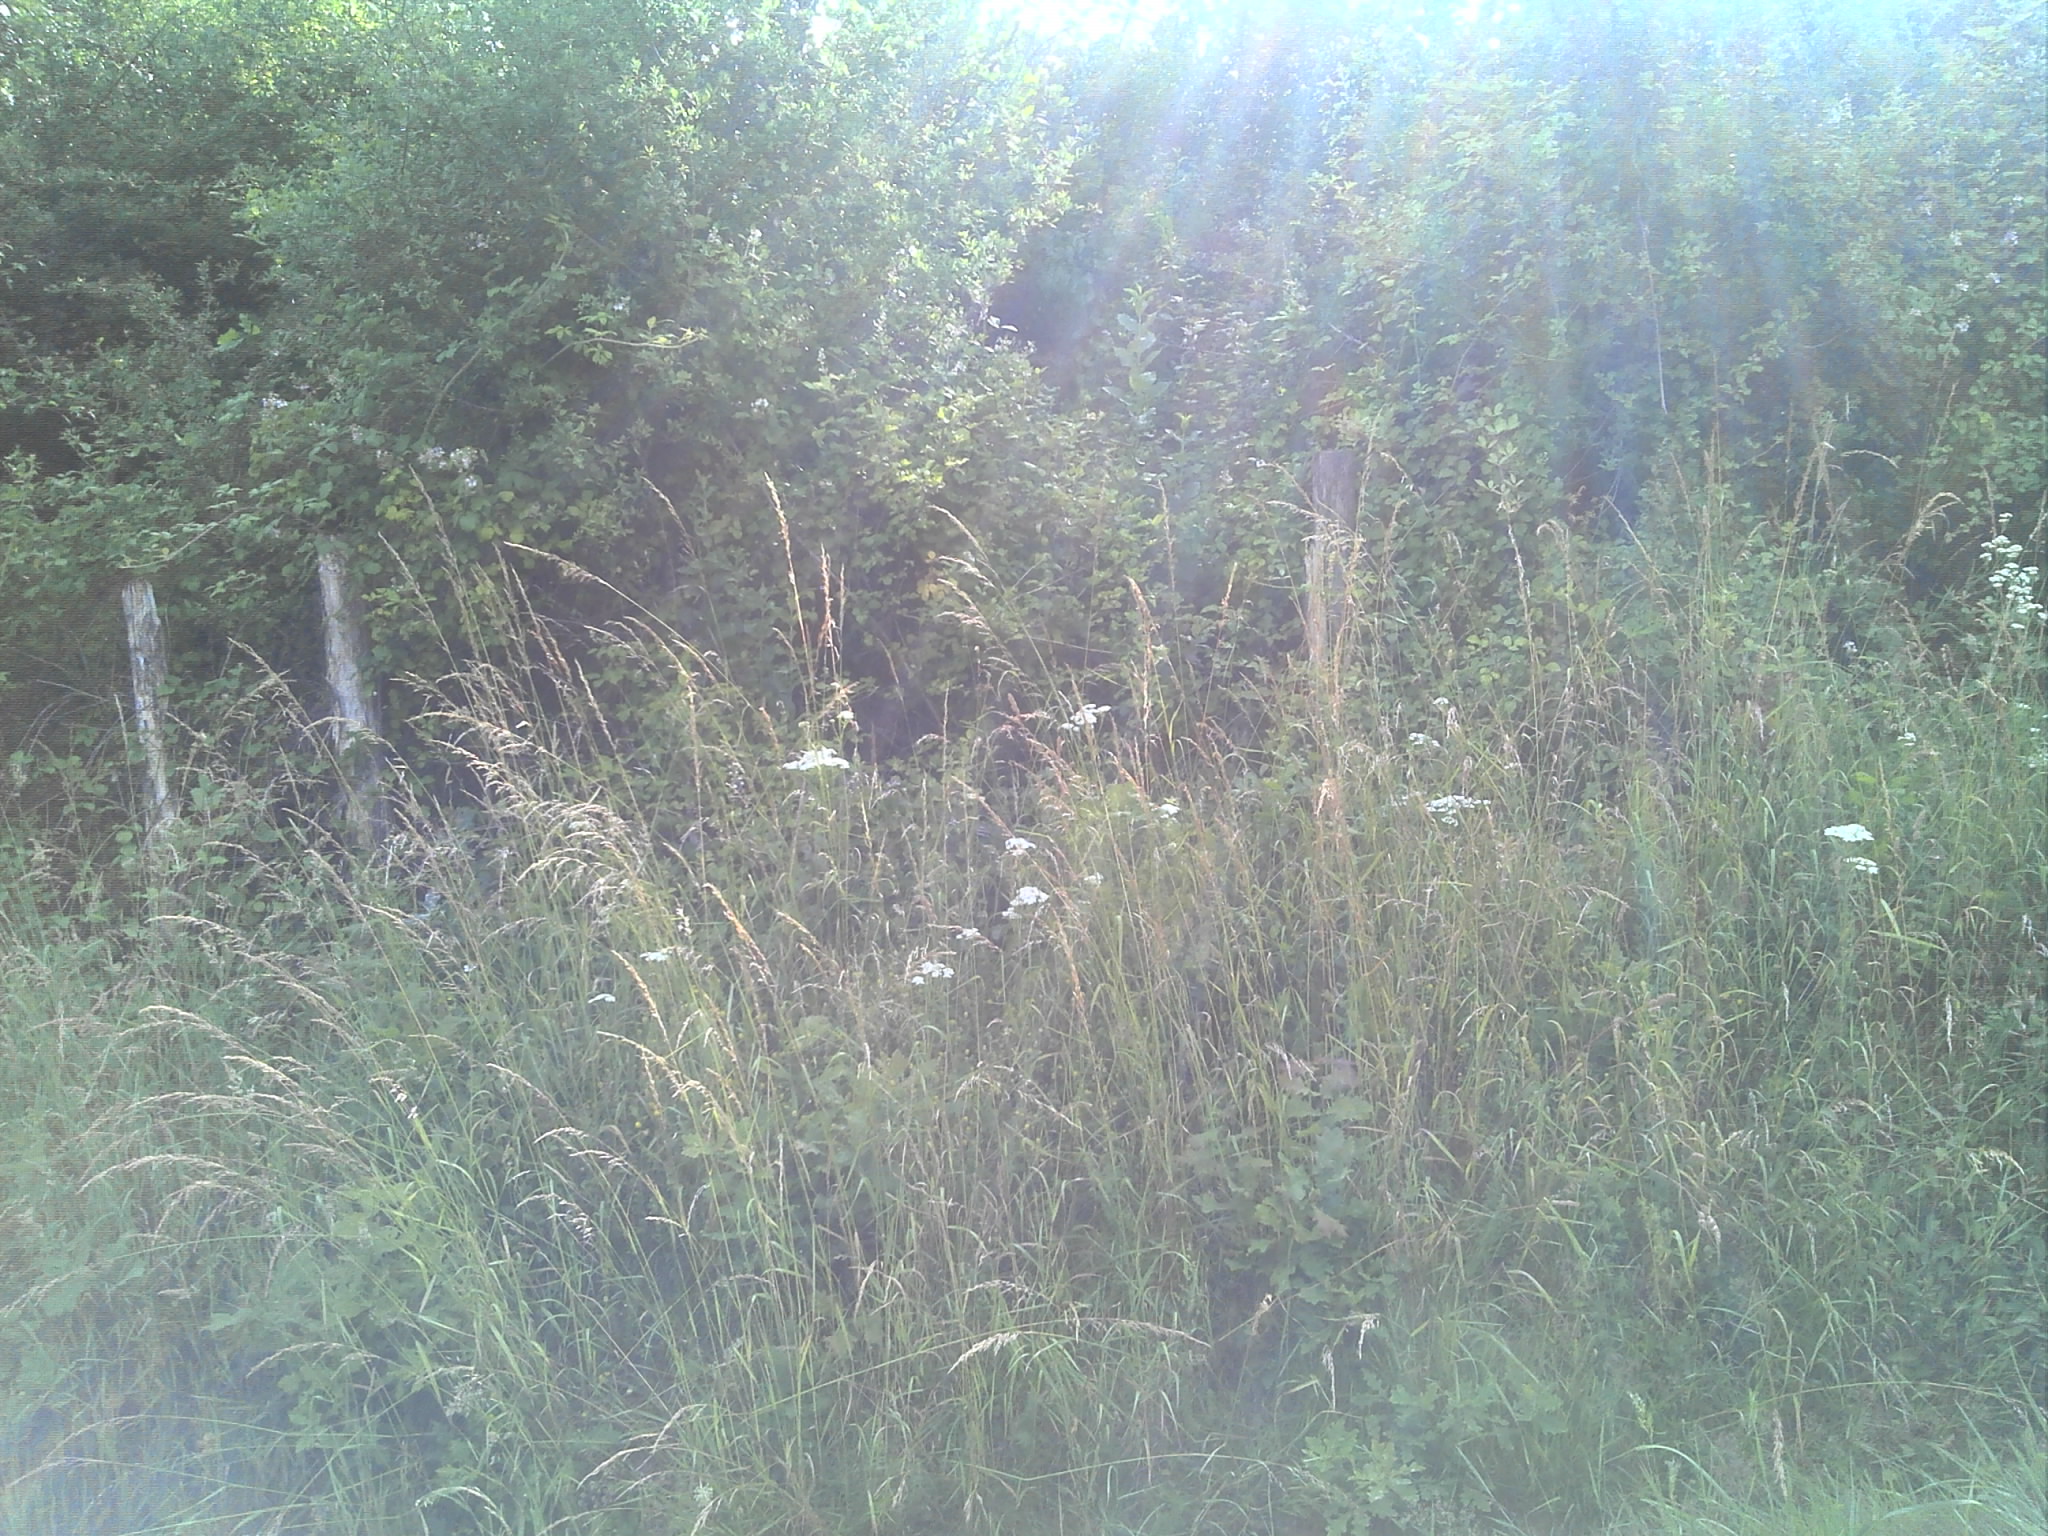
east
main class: Woodland
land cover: Broadleaved woodland
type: mesophytic deciduous forest
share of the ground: > 75 %
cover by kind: broadleaved forest trees 50 %, shrubs 50 %
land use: Semi-natural and natural areas not in use
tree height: < 5 m
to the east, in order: Grass margins; Ditches and canals; Broadleaved woodland; Grassland with sparse tree/shrub cover; Fences; Grassland with sparse tree/shrub cover; Paved roads, cycling and walking lanes; Grass margins; Ditches and canals; Electric lines; Grassland with sparse tree/shrub cover; Tracks; Fences; Broadleaved woodland
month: June
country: FR
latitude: 46.5575
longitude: 1.5241
